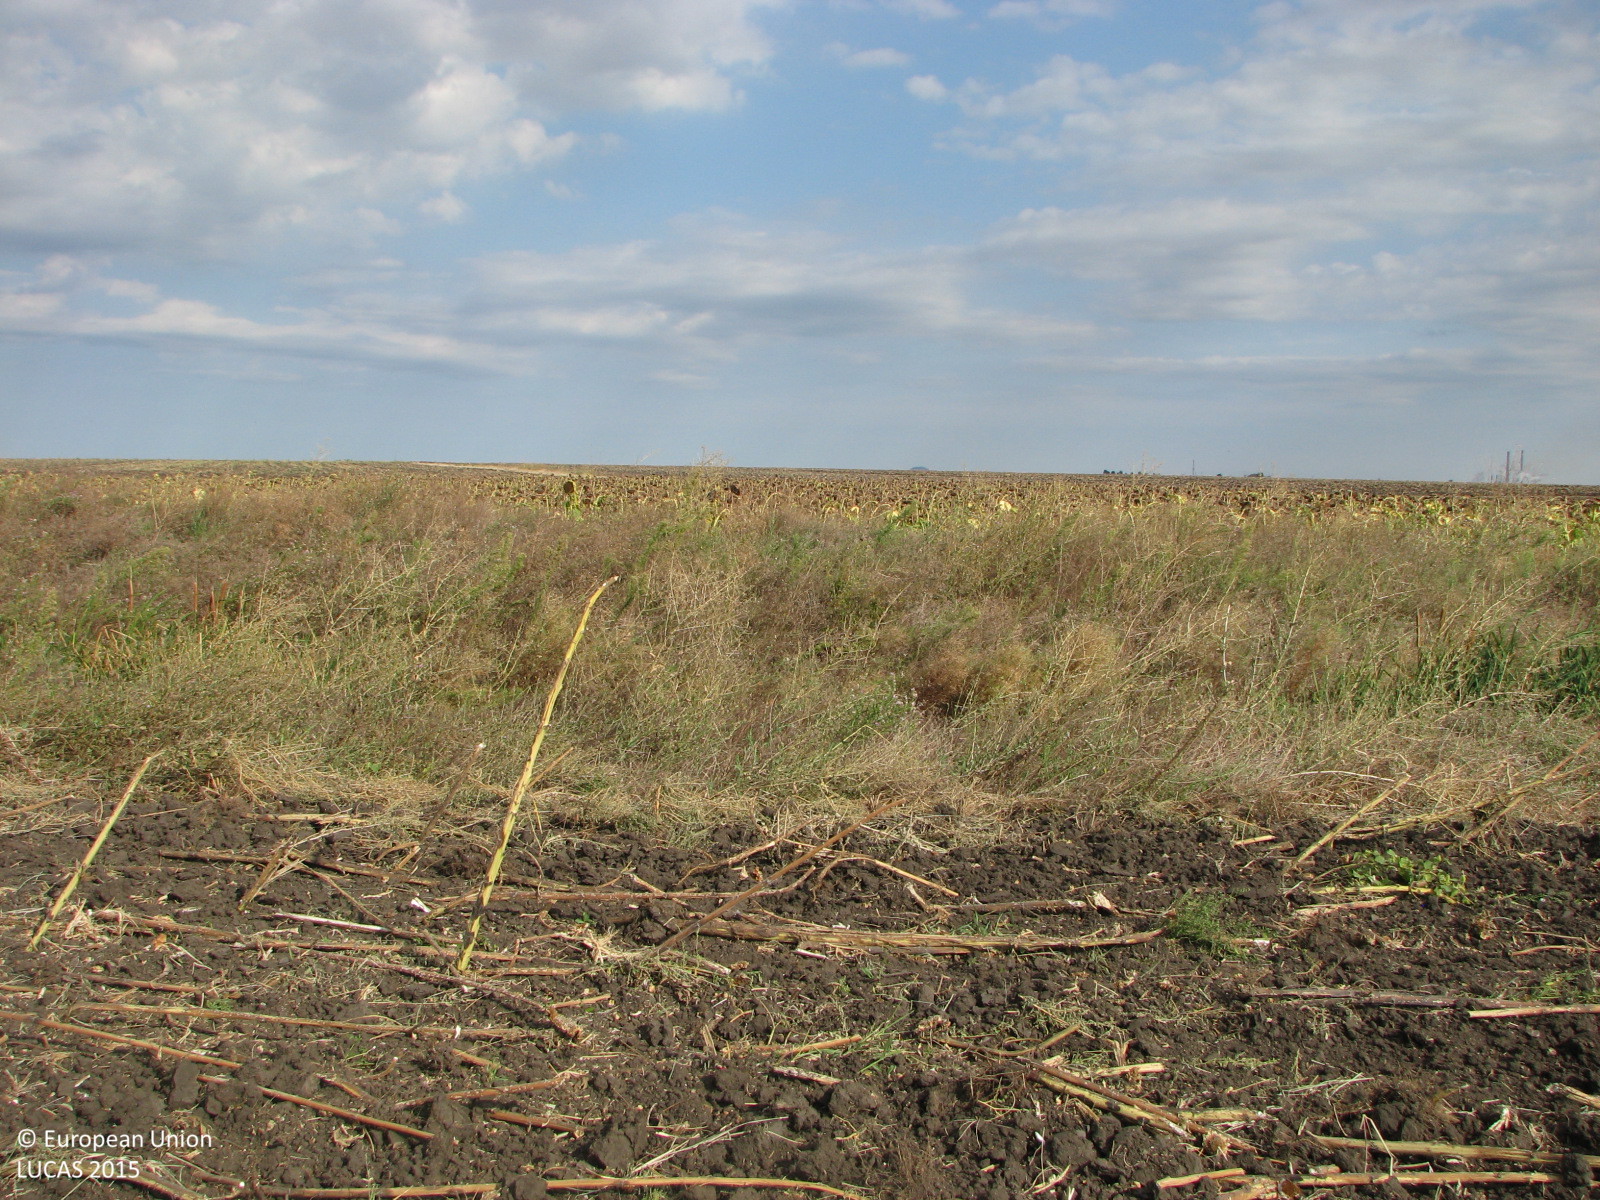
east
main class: Cropland
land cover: Sunflower
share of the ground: < 10 %
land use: Agriculture (excluding fallow land and kitchen gardens)
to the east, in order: Sunflower; Grass margins; Ditches and canals; Grass margins; Sunflower; Tracks; Arable land (only in case pi)
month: September
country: BG
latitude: 42.3222
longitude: 26.0358
